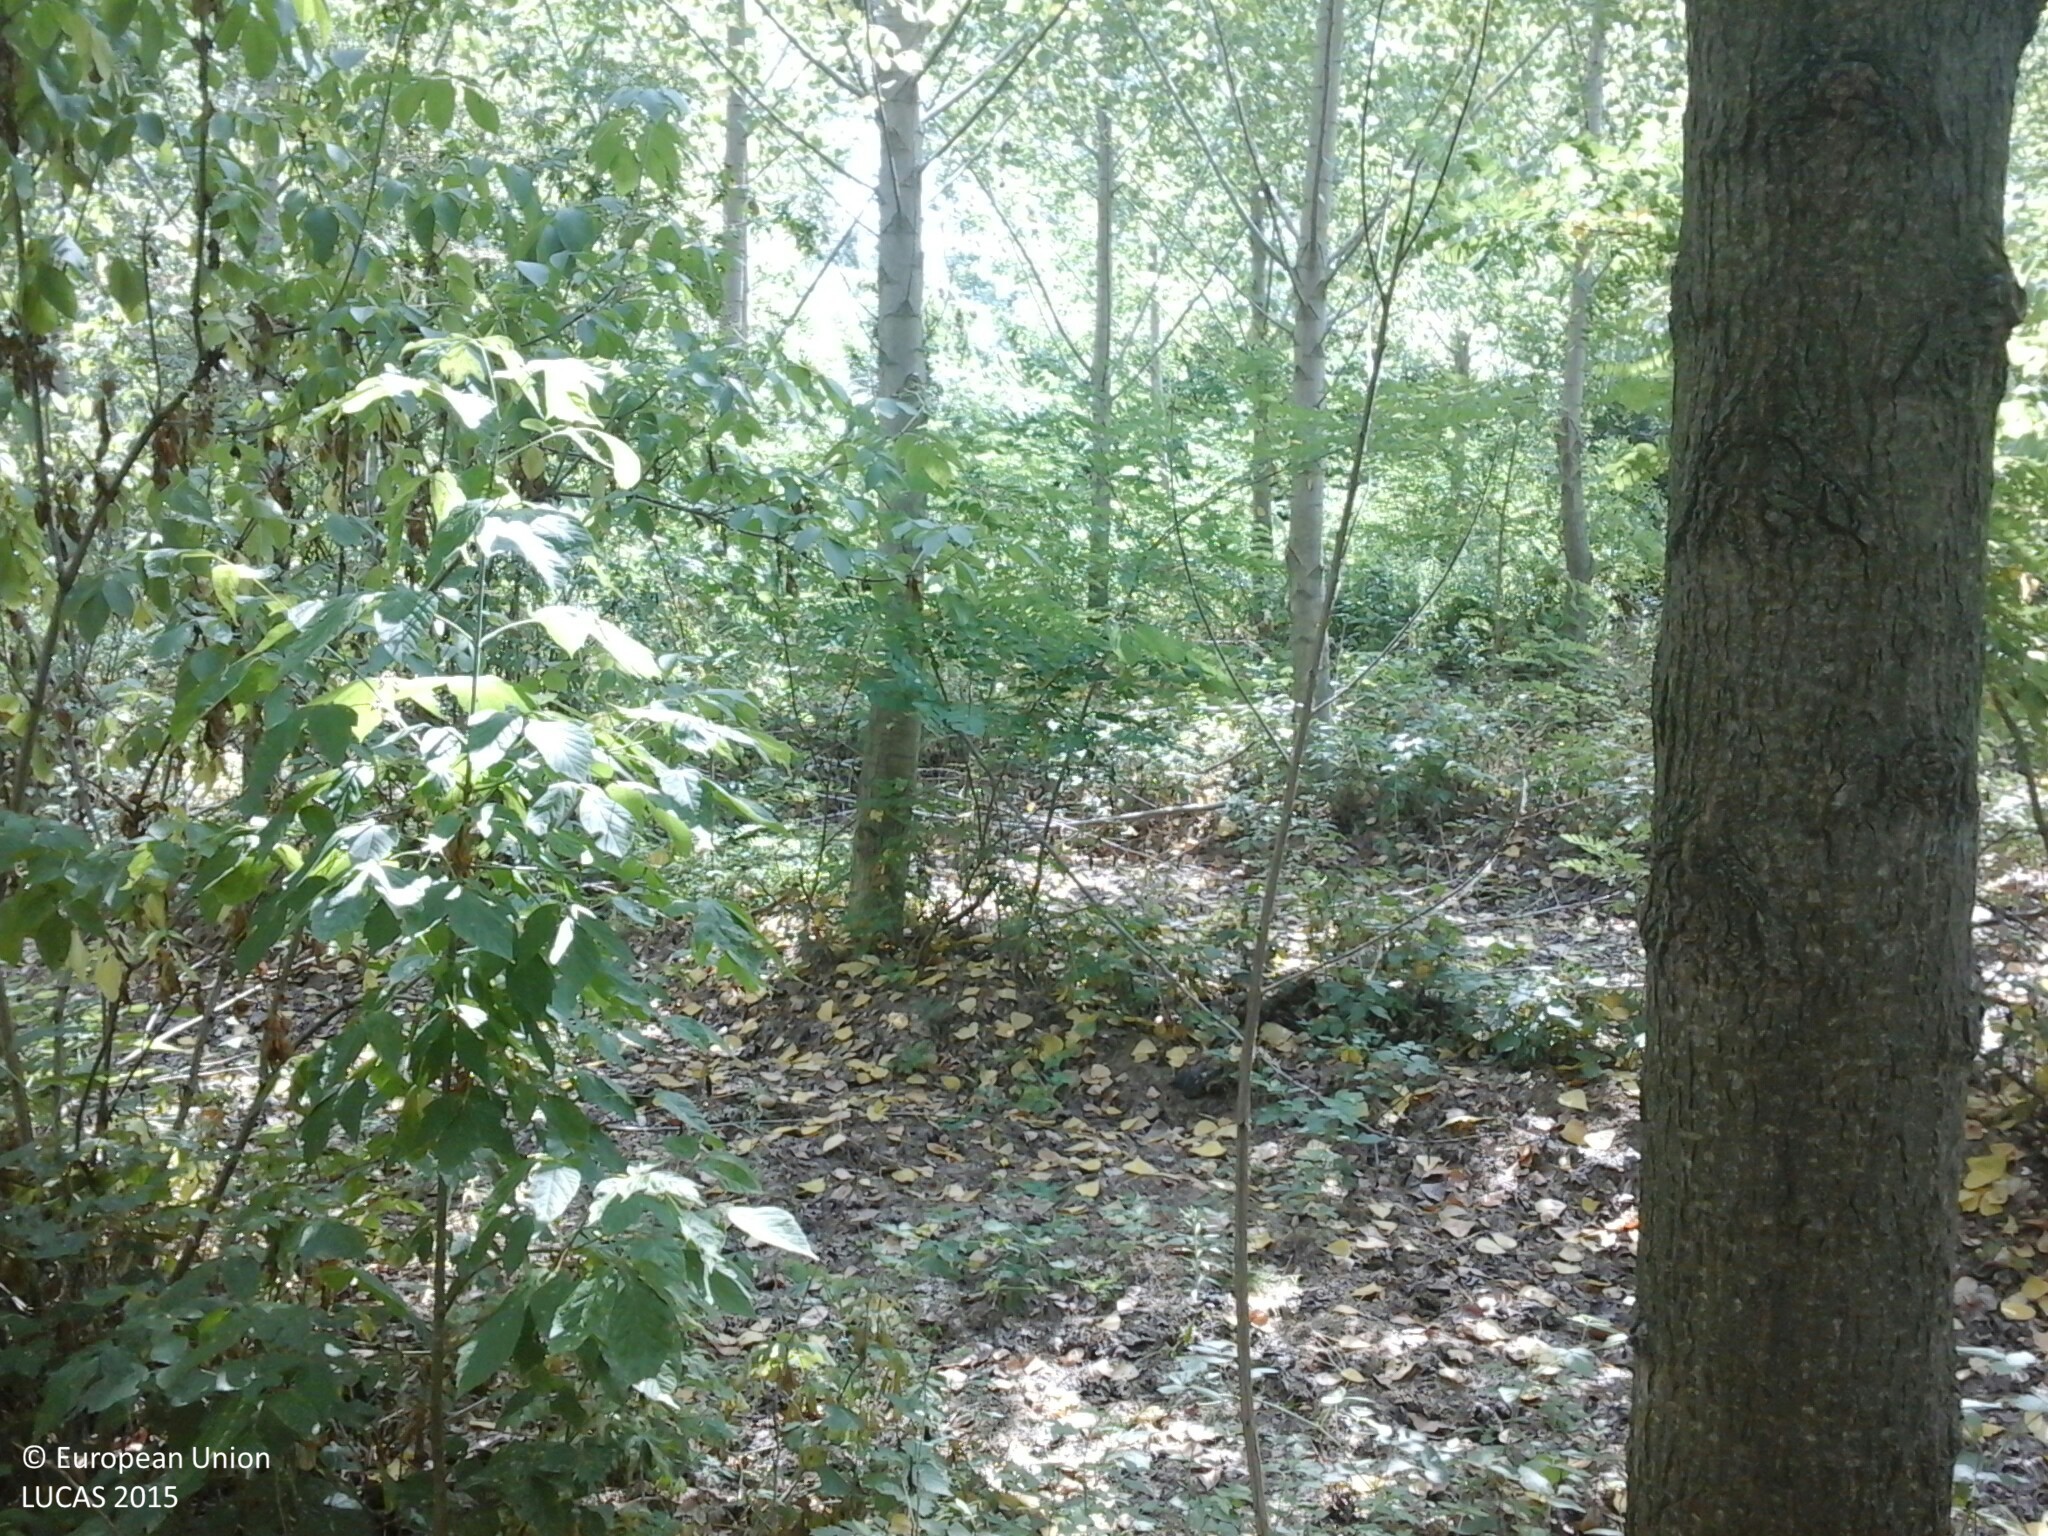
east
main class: Woodland
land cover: Broadleaved woodland
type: floodplain forest
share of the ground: > 75 %
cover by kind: broadleaved forest trees 100 %
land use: Forestry
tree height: > 5 m
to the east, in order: Broadleaved woodland; Spontaneously vegetated surfaces; Broadleaved woodland; Inland fresh running water
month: July
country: HU
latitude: 48.3923
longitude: 22.2526
